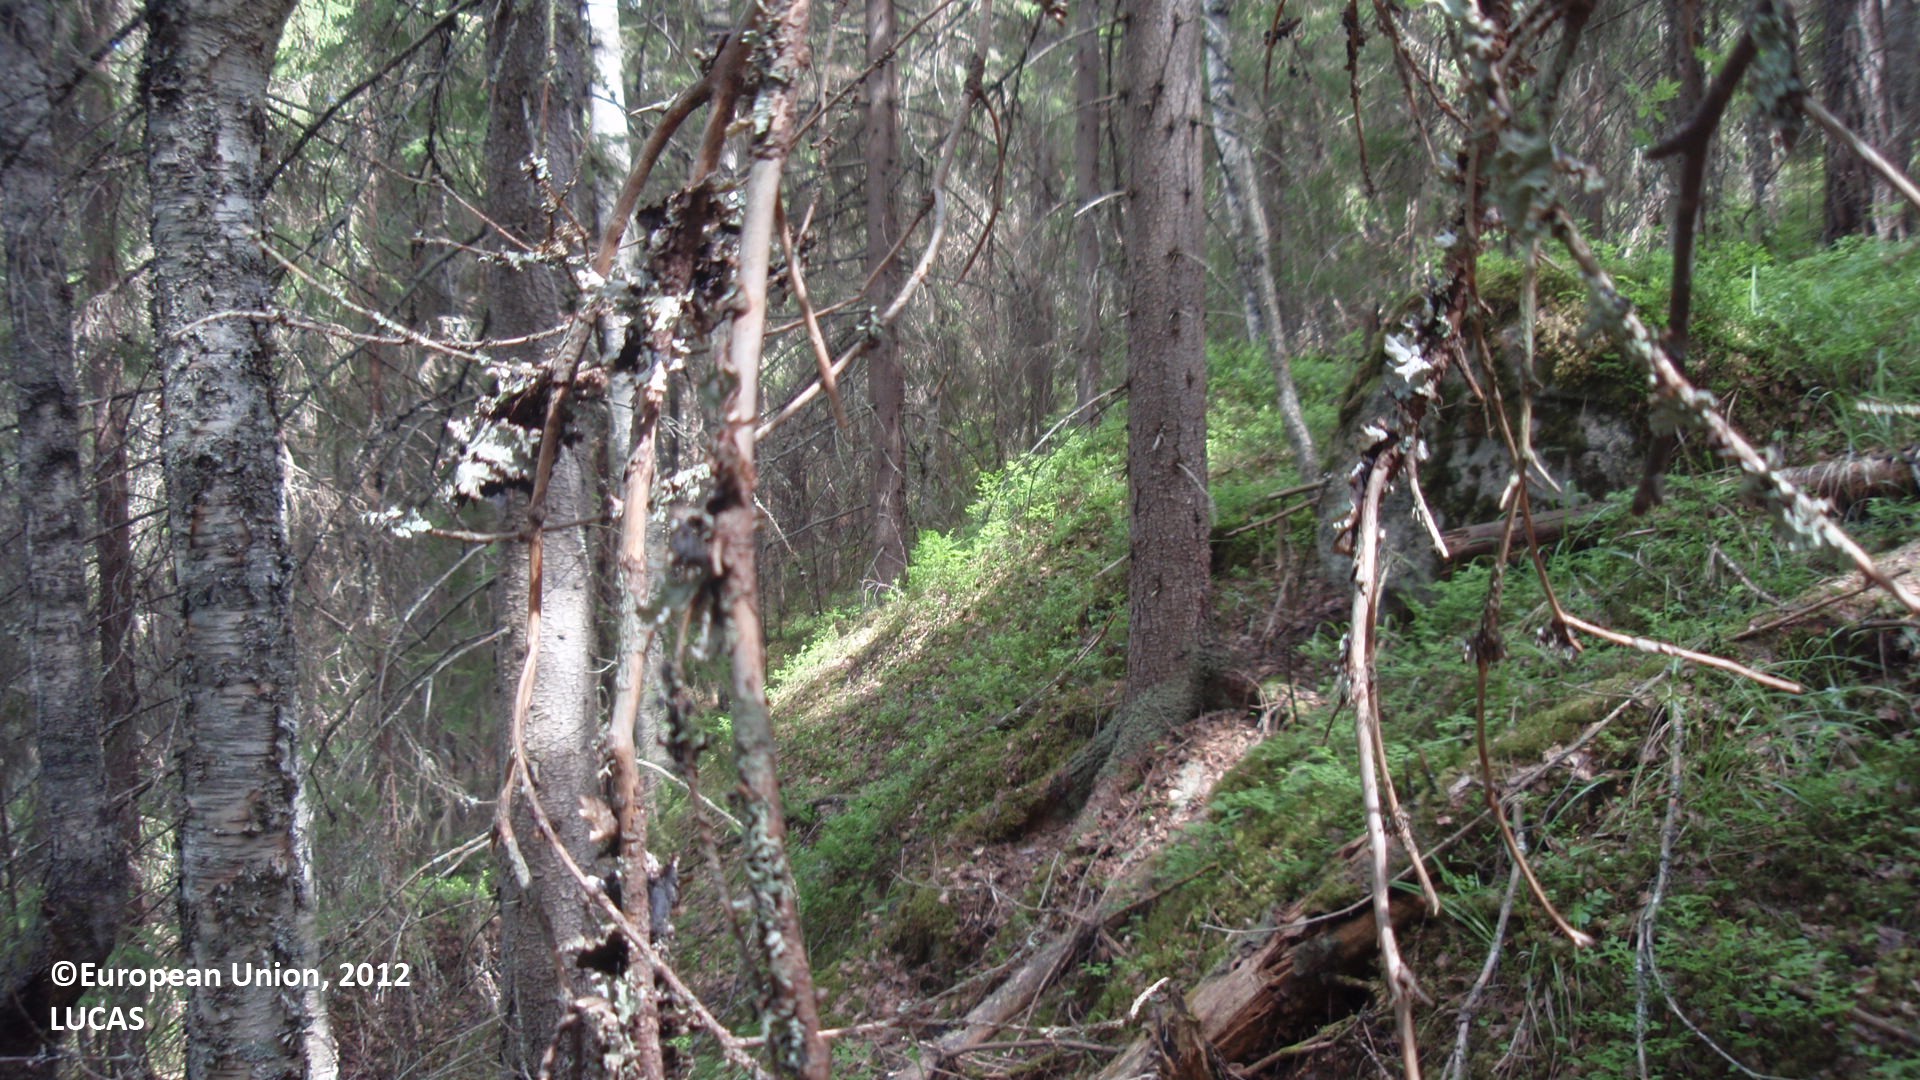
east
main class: Woodland
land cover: Spruce dominated mixed woodland
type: boreal forest
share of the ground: 25 - 50 %
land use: Forestry
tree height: > 5 m
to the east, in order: Spruce dominated mixed woodland; Spruce dominated coniferous woodland; Spruce dominated mixed woodland; Pine dominated coniferous woodland
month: June
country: FI
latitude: 61.3938
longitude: 26.9948
